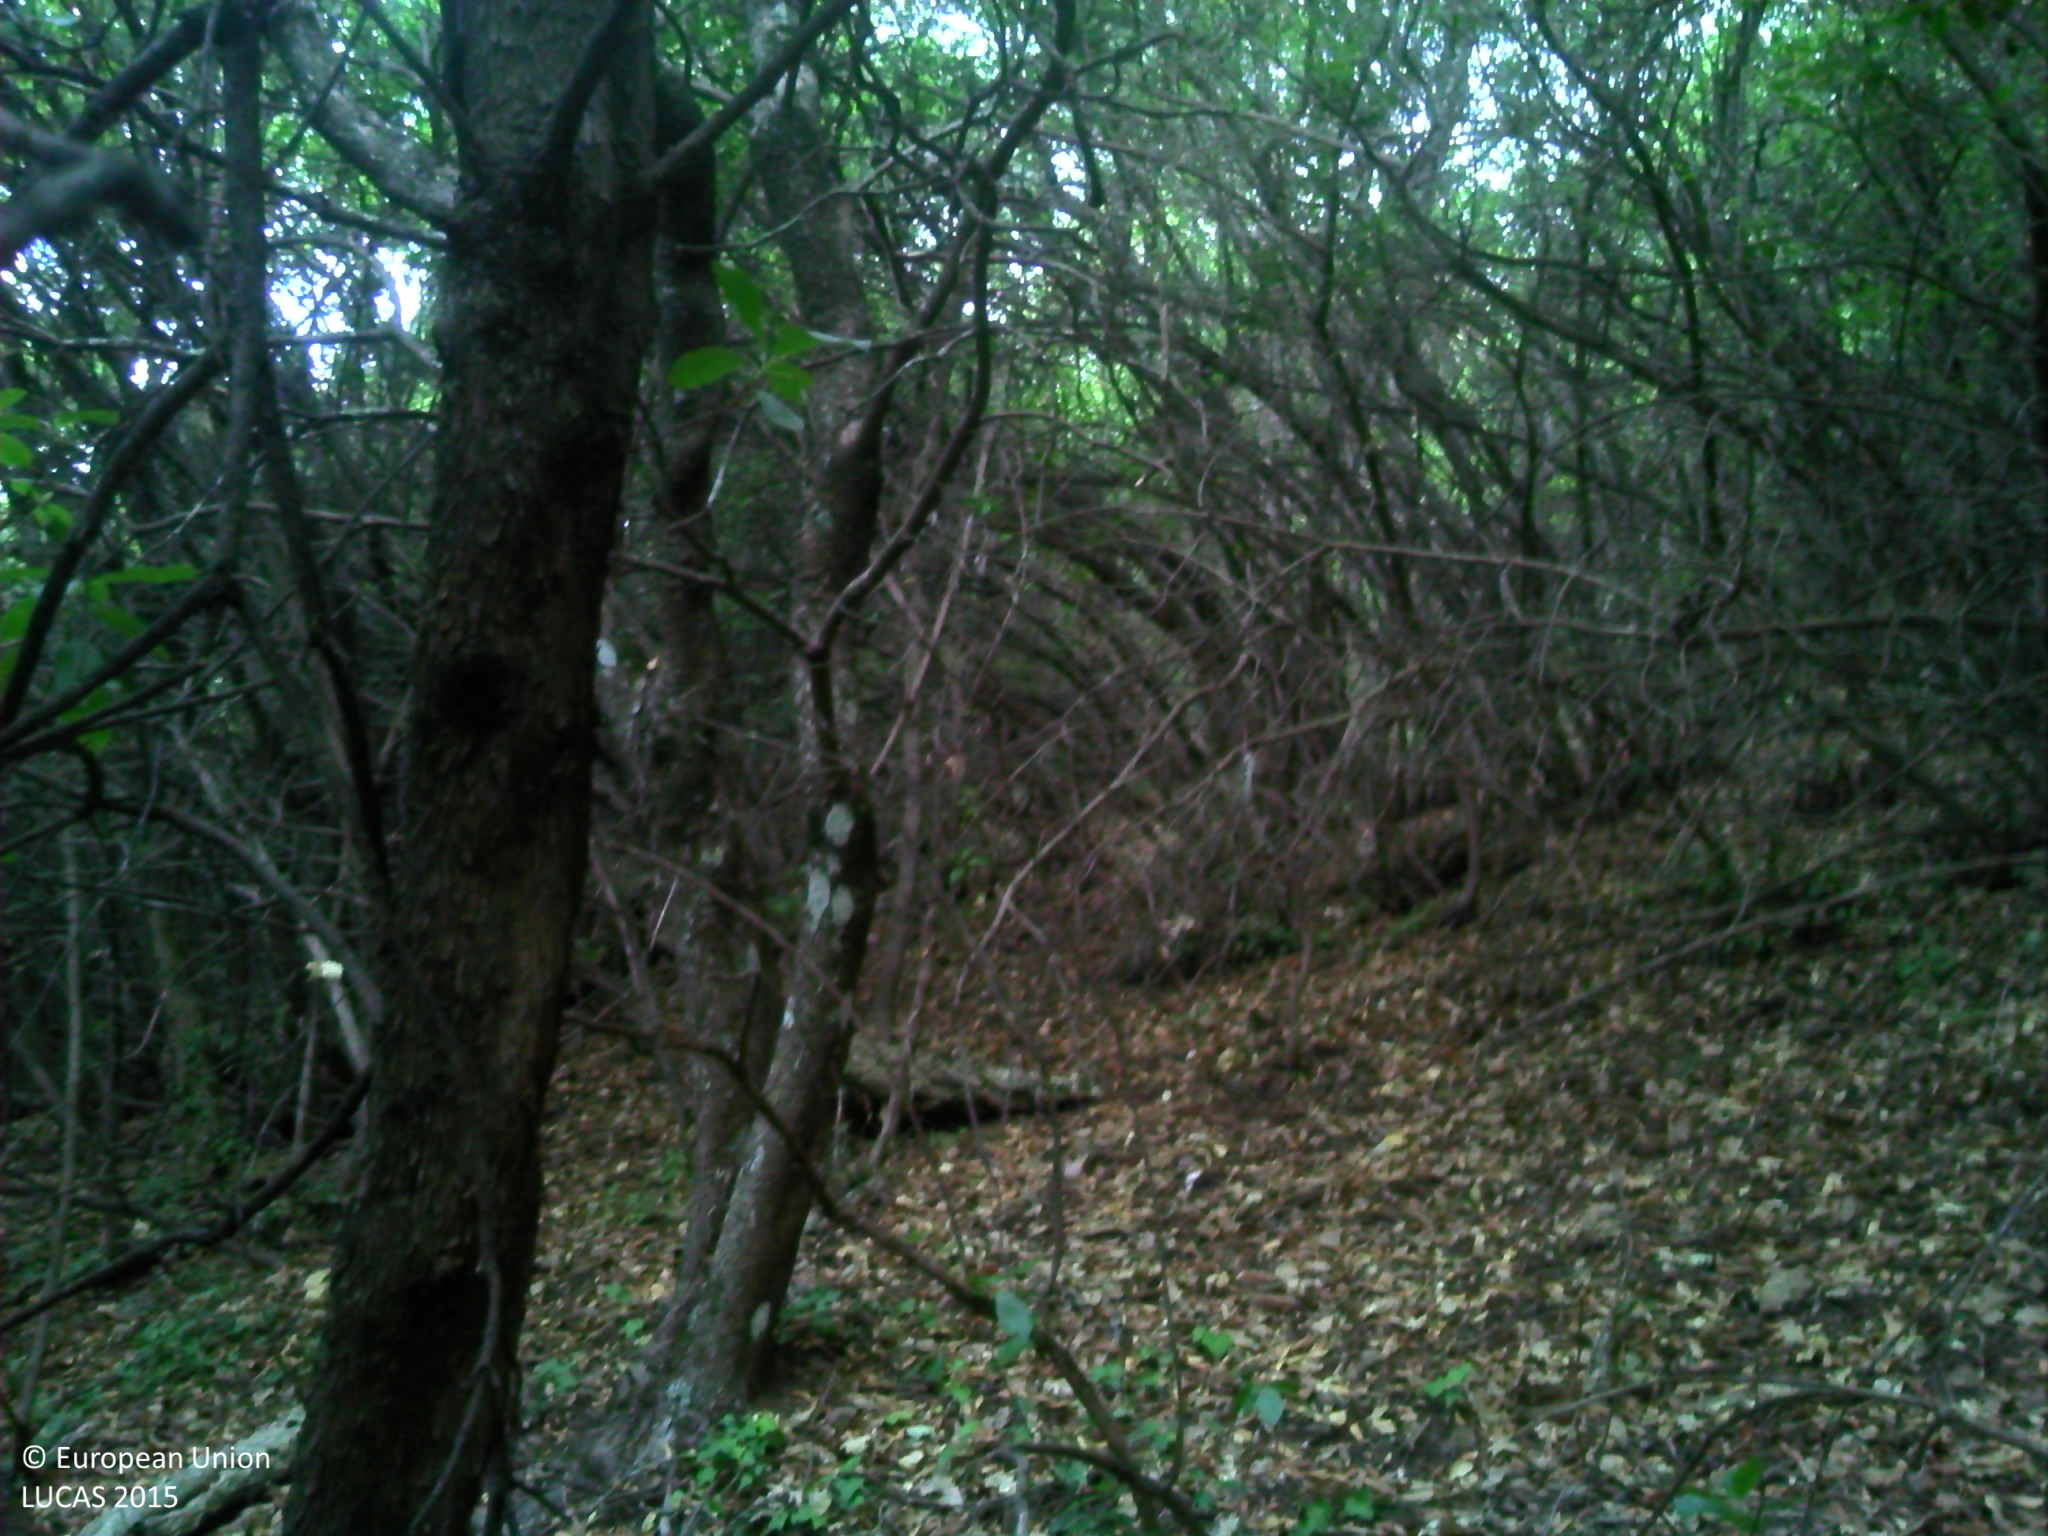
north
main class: Woodland
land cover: Broadleaved woodland
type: broadleaved evergreen forest
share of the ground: > 75 %
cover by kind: broadleaved forest trees 80 %, shrubs 20 %
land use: Semi-natural and natural areas not in use
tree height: > 5 m
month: July
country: FR
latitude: 43.2732
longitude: 6.3006
